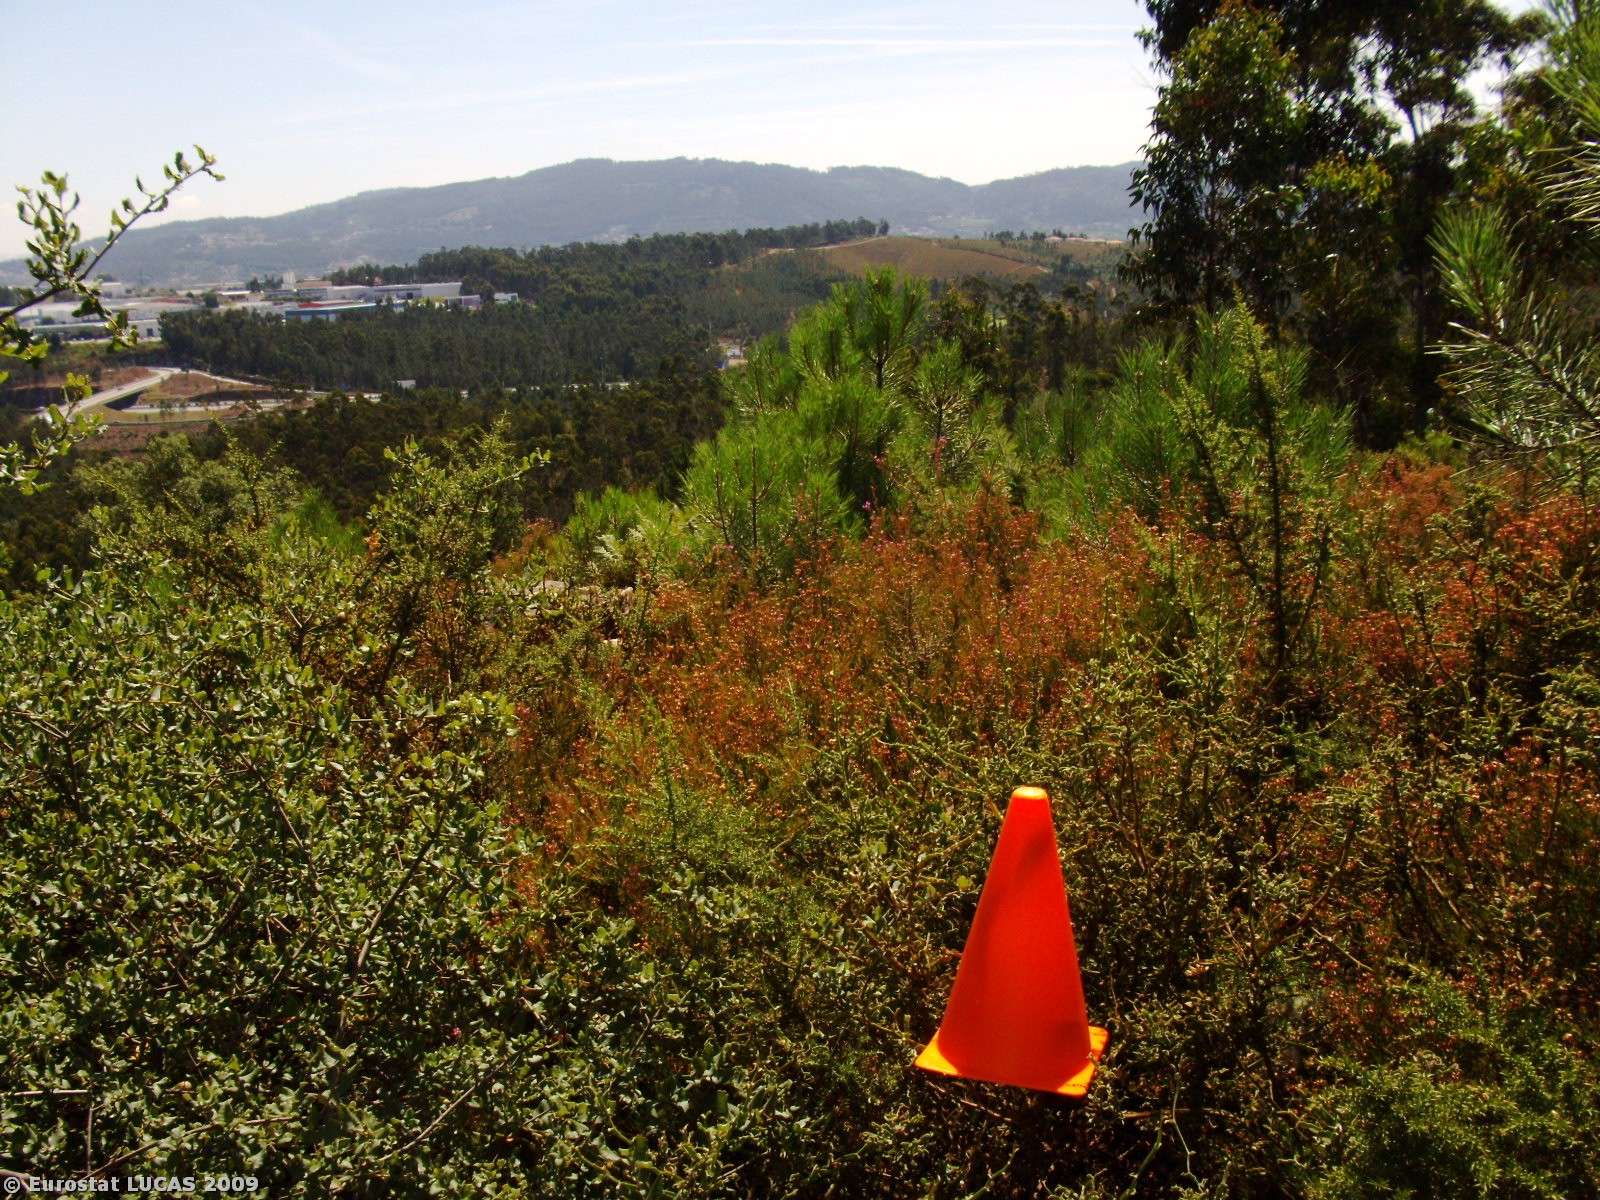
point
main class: Shrubland
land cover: Shrubland without tree cover
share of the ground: > 75 %
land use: Forestry
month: July
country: PT
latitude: 41.3351
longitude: -8.5190
